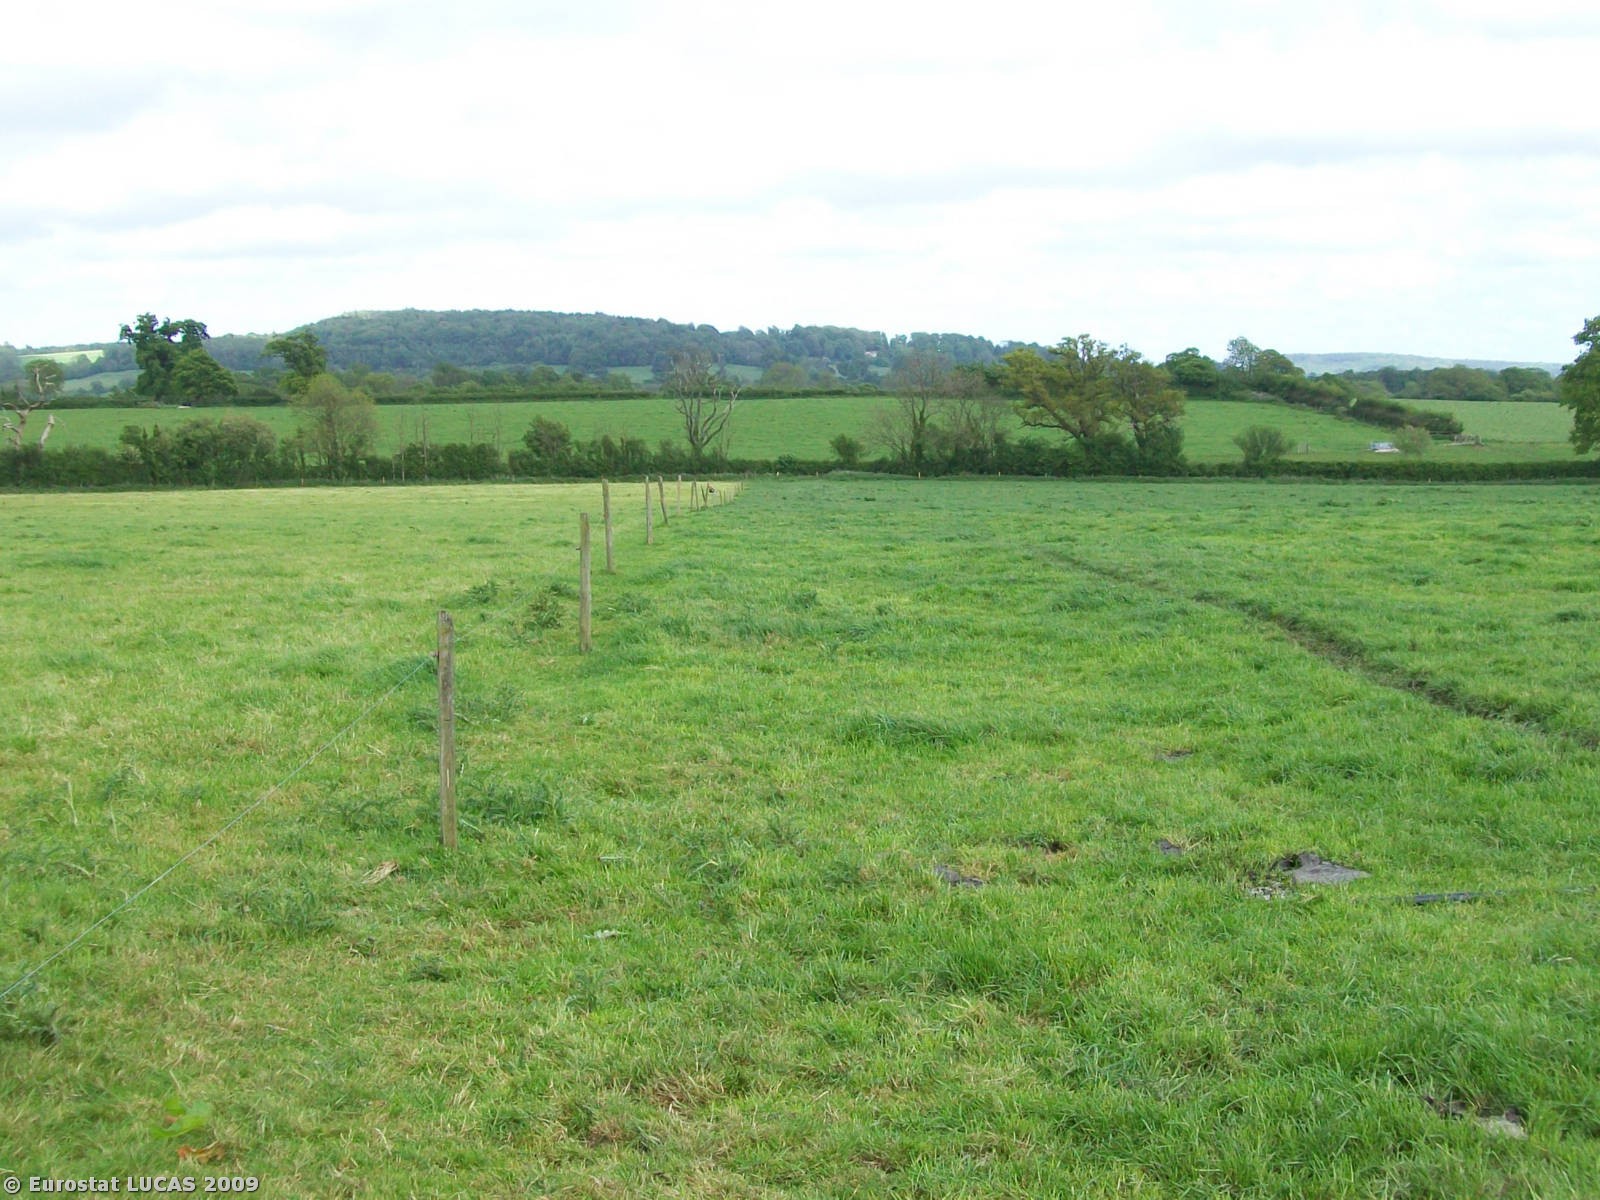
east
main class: Grassland
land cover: Grassland without tree/shrub cover
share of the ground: > 75 %
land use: Agriculture (excluding fallow land and kitchen gardens)
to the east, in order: Grassland without tree/shrub cover; Fences; Grassland without tree/shrub cover; Fences; Spontaneously vegetated surfaces; Managed hedges; Rivers and streams; Managed hedges; Grassland without tree/shrub cover
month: May
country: GB
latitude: 51.0569
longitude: -2.1739
